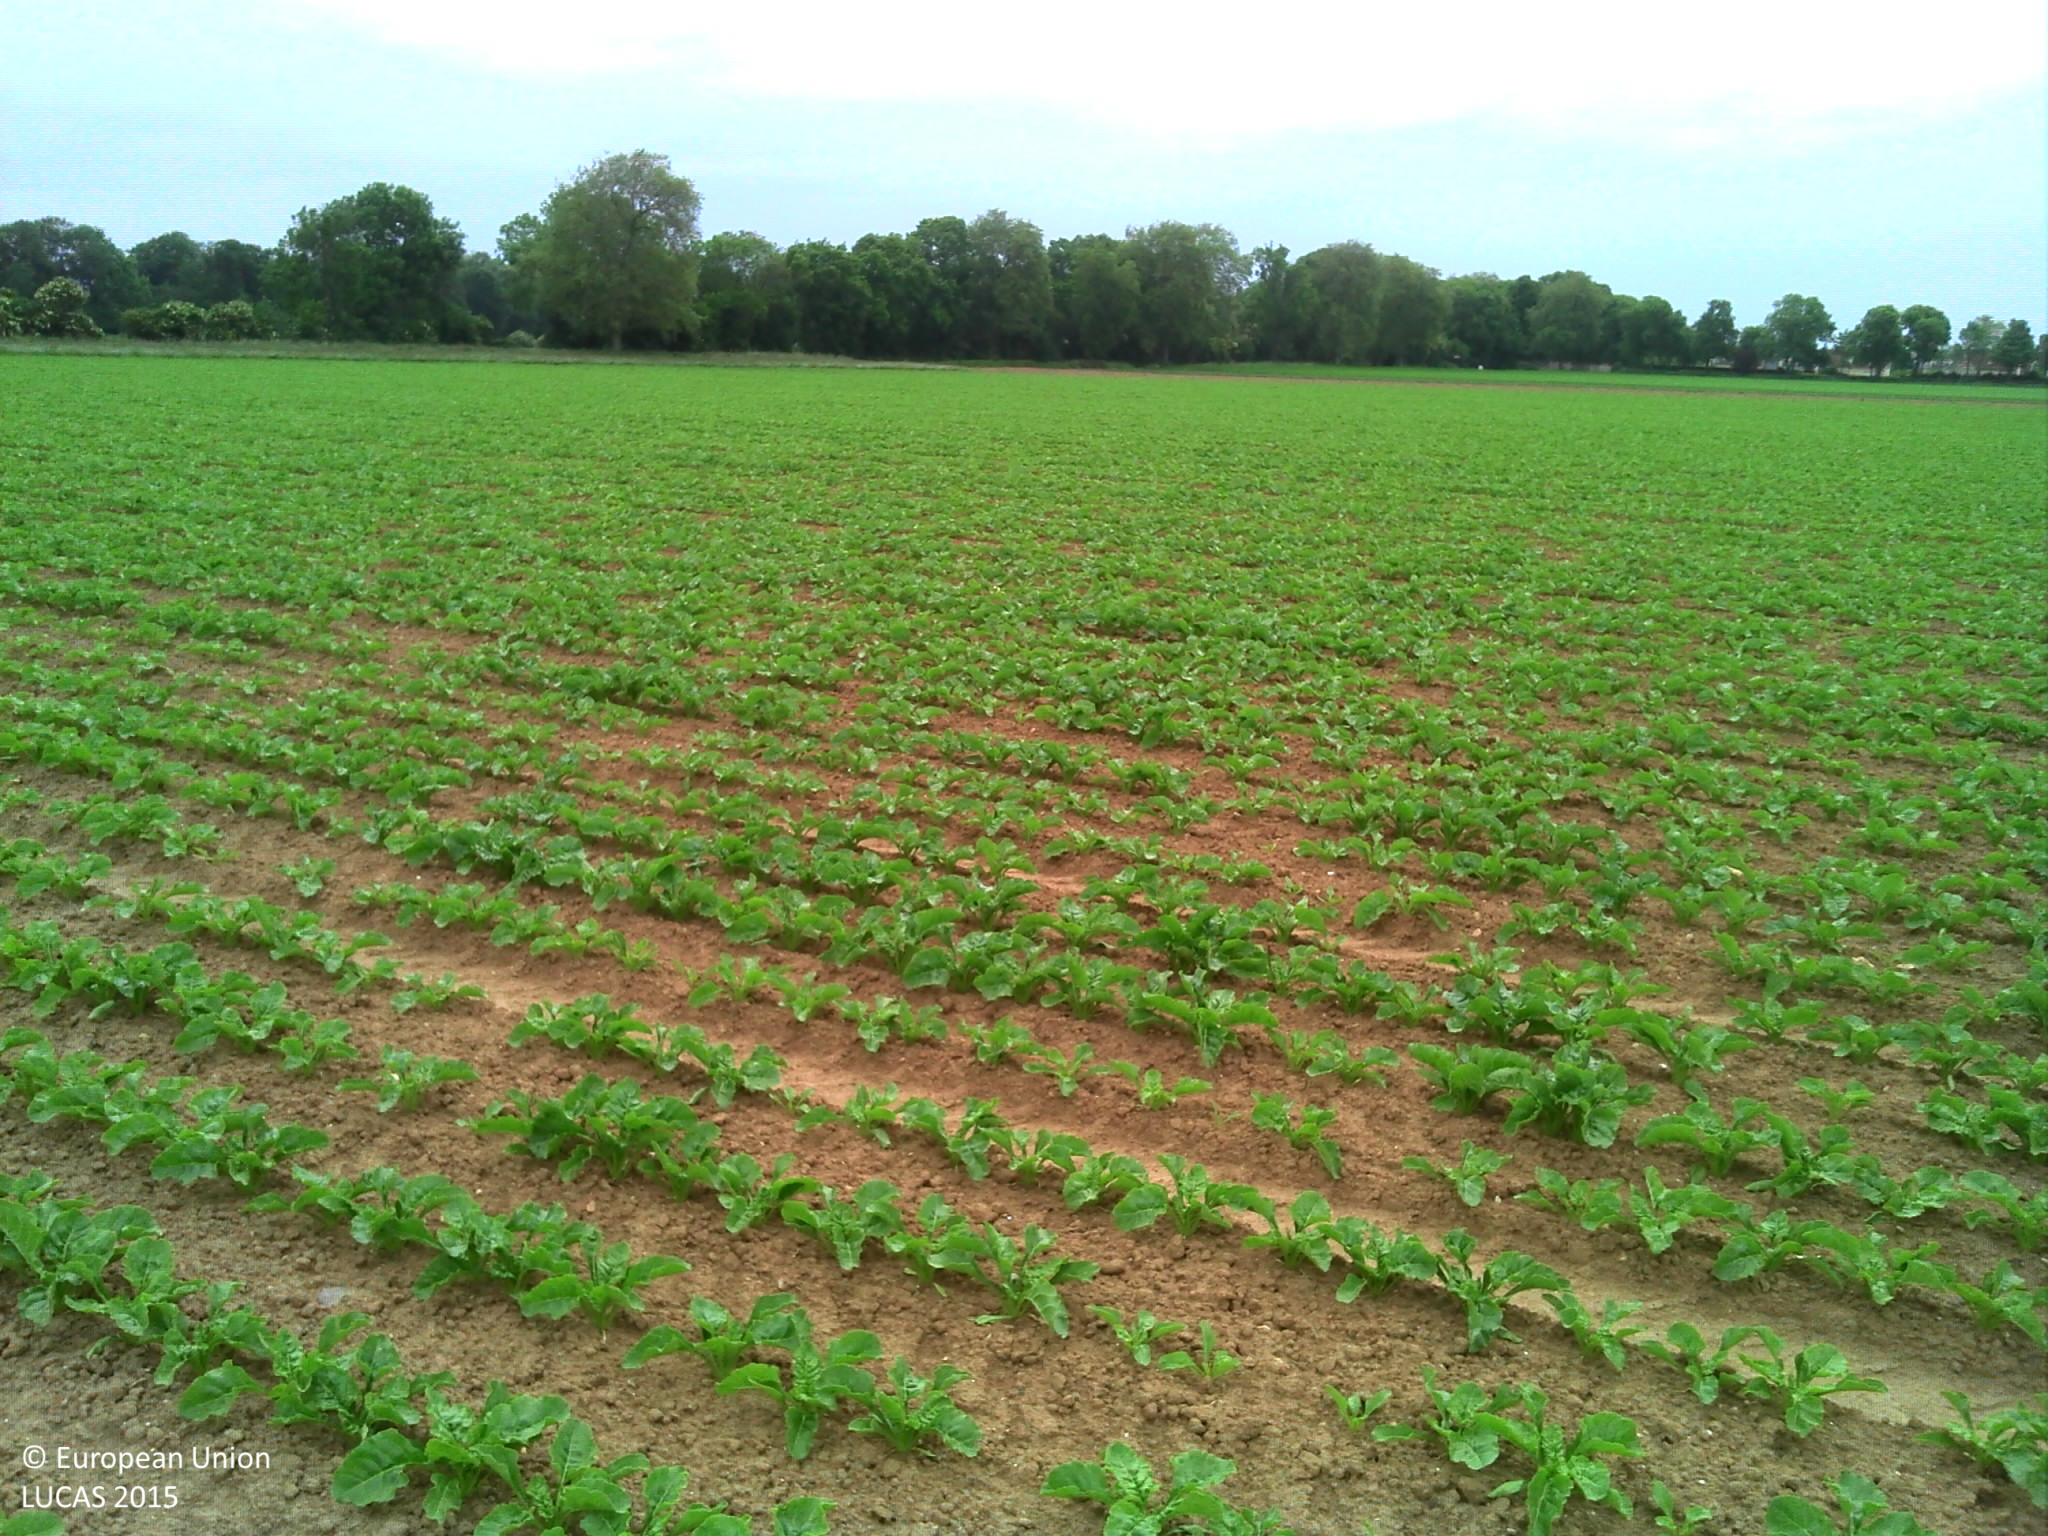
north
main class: Cropland
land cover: Sugar beet
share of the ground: 25 - 50 %
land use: Agriculture (excluding fallow land and kitchen gardens)
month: May
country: FR
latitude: 49.2963
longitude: -0.3341
